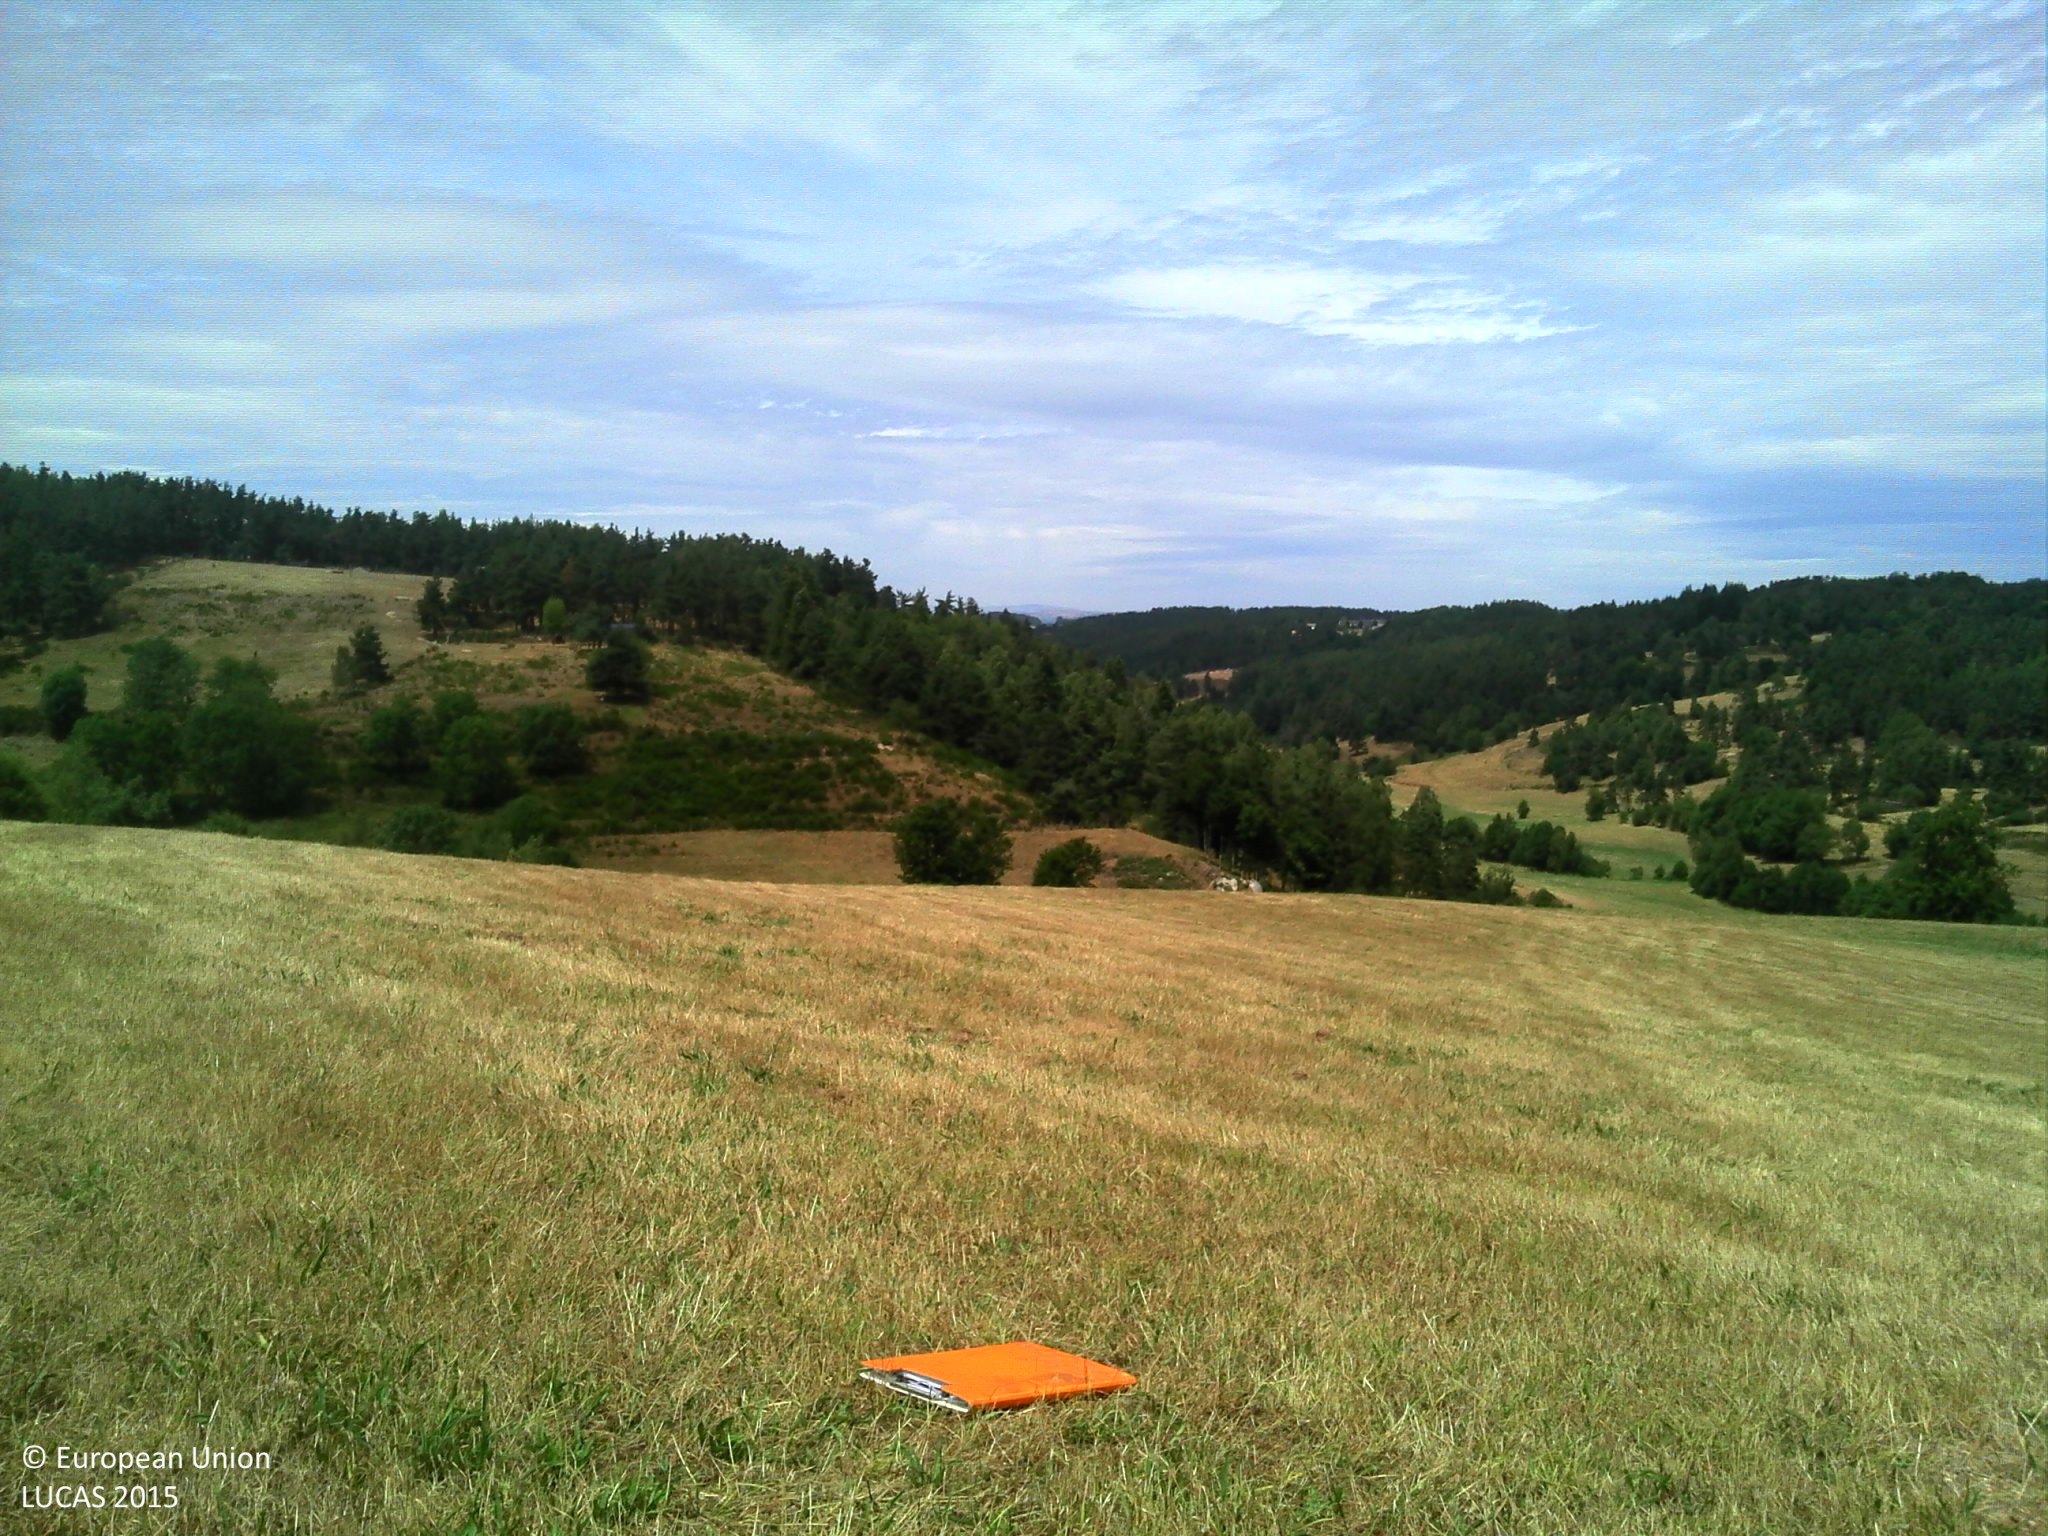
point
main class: Grassland
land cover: Grassland without tree/shrub cover
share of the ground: > 75 %
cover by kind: herbaceous plants 100 %
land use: Agriculture (excluding fallow land and kitchen gardens)
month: July
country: FR
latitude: 44.8712
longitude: 3.2315
